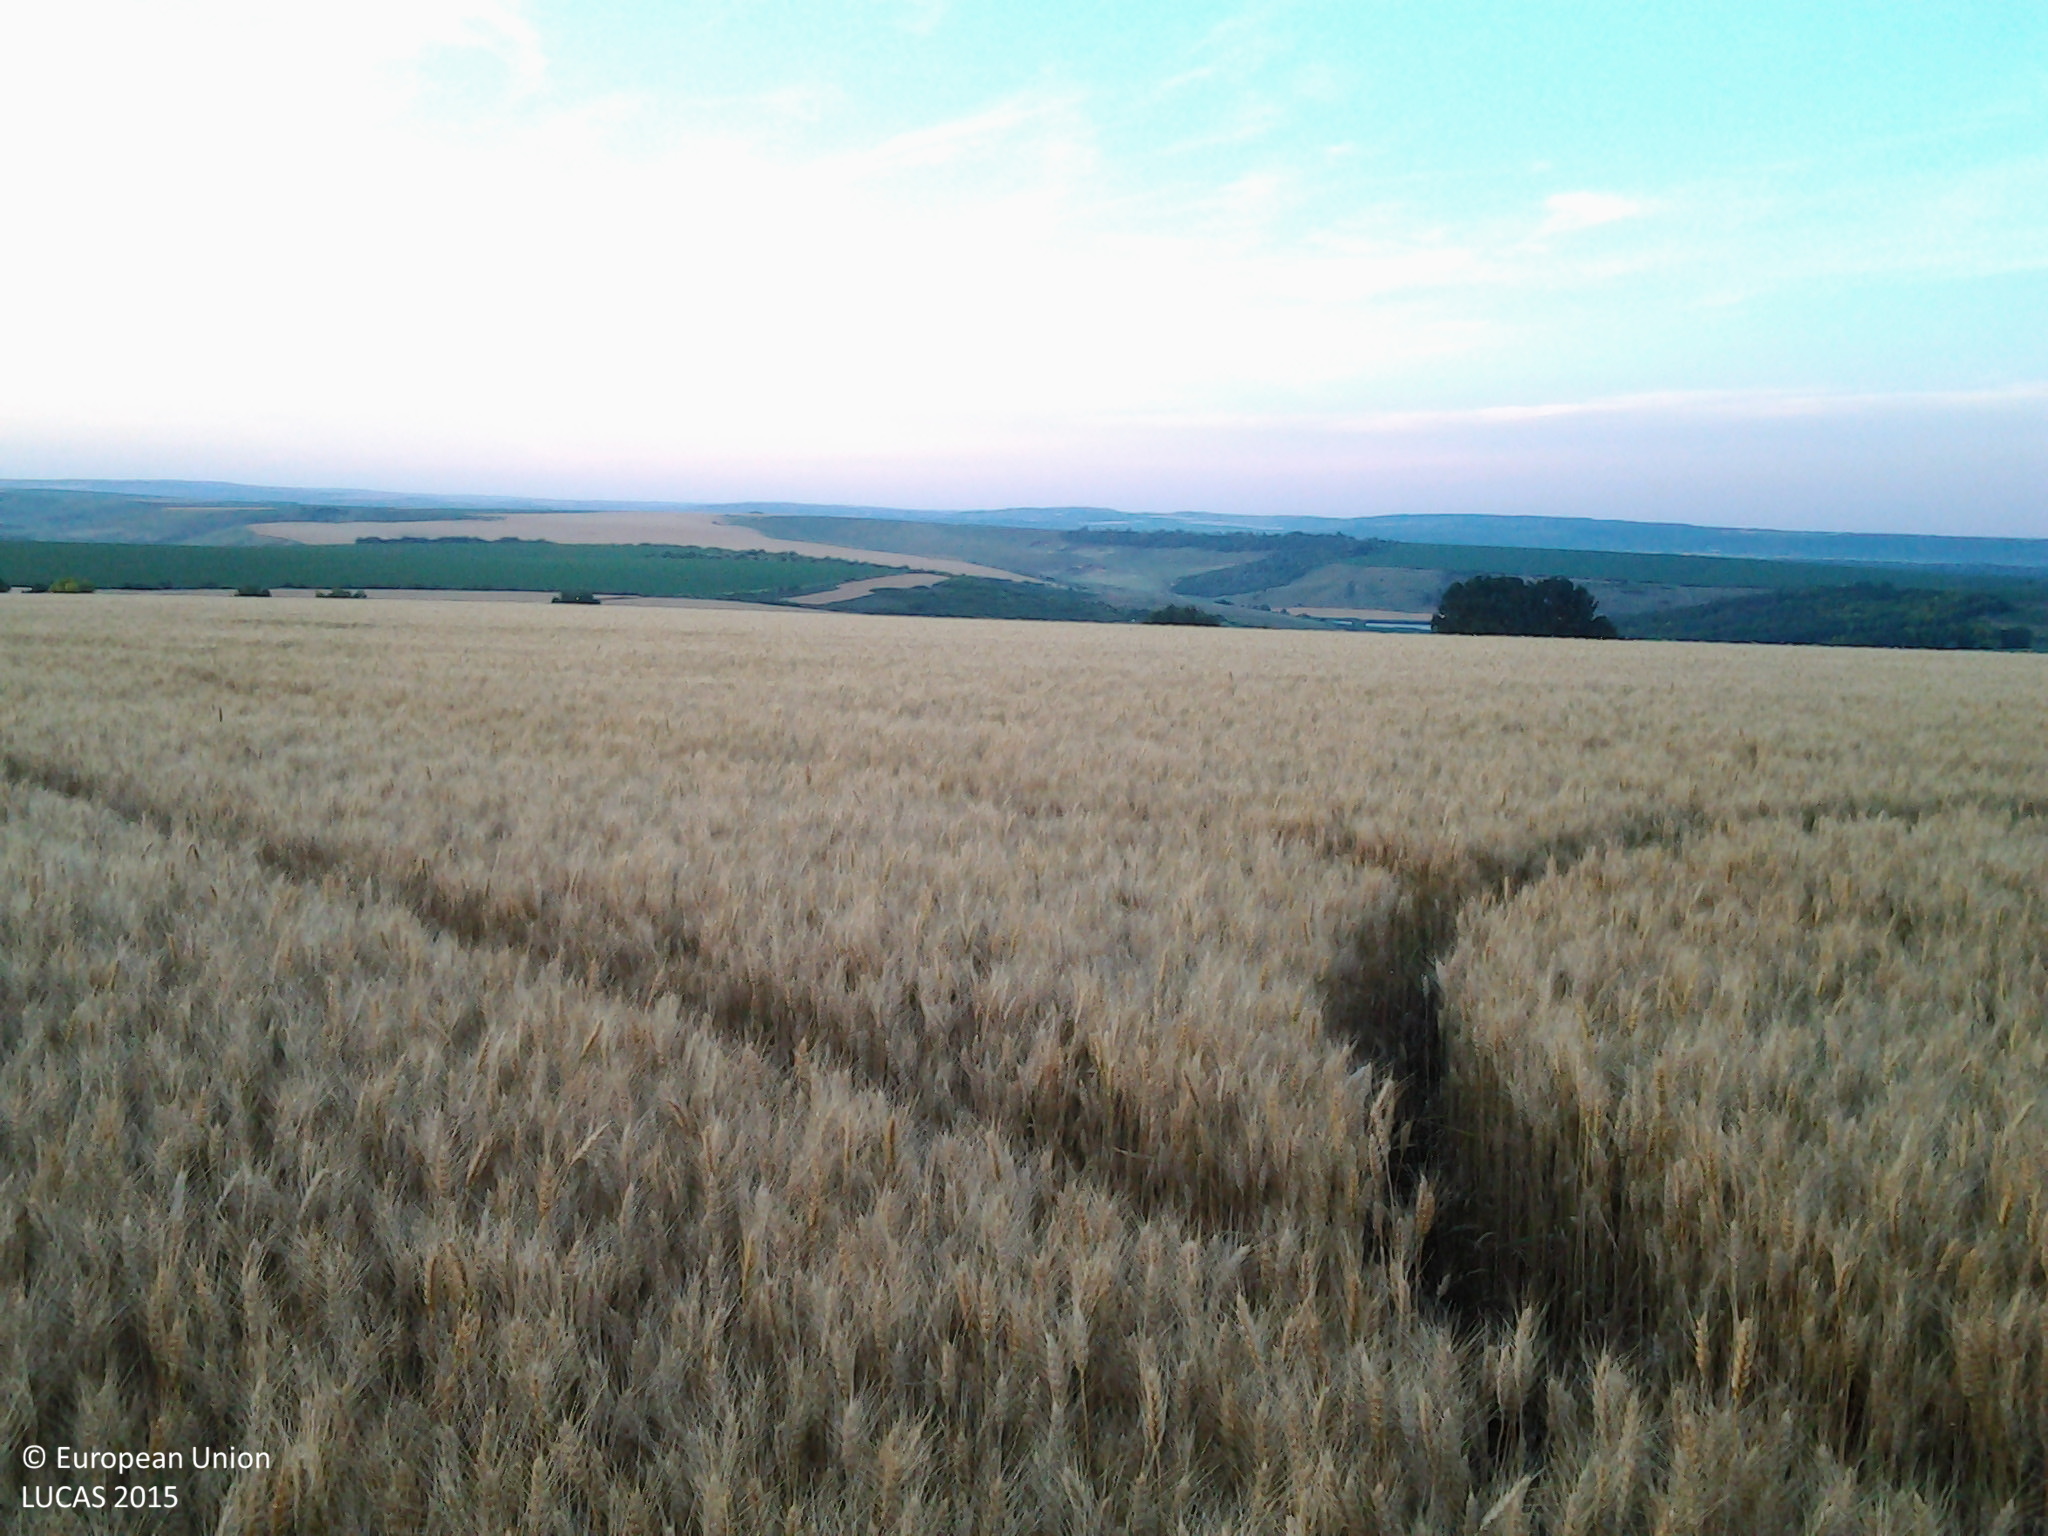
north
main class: Cropland
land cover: Common wheat
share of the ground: > 75 %
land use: Agriculture (excluding fallow land and kitchen gardens)
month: June
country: RO
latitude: 47.4908
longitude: 27.3826
